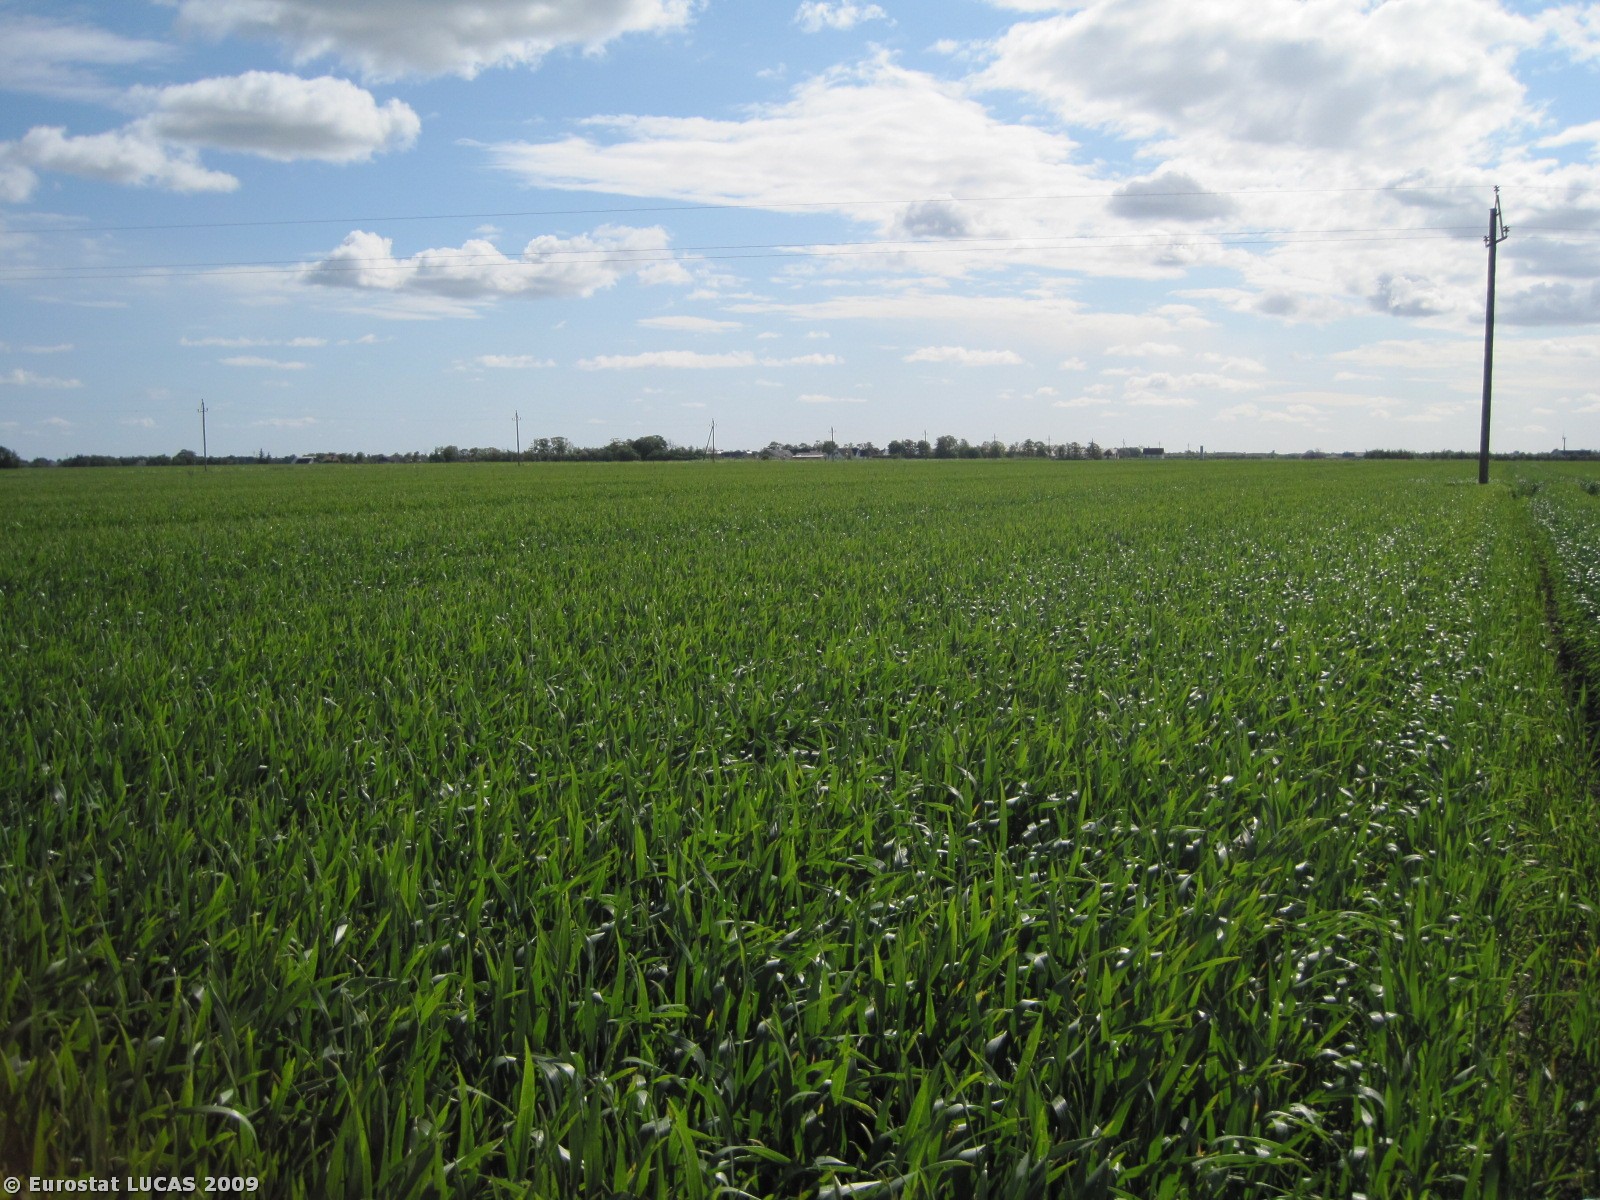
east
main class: Cropland
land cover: Common wheat
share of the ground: > 75 %
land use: Agriculture (excluding fallow land and kitchen gardens)
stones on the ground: < 10 %
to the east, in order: Common wheat; Electric lines; Common wheat
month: June
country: DK
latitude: 56.9786
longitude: 10.1479
